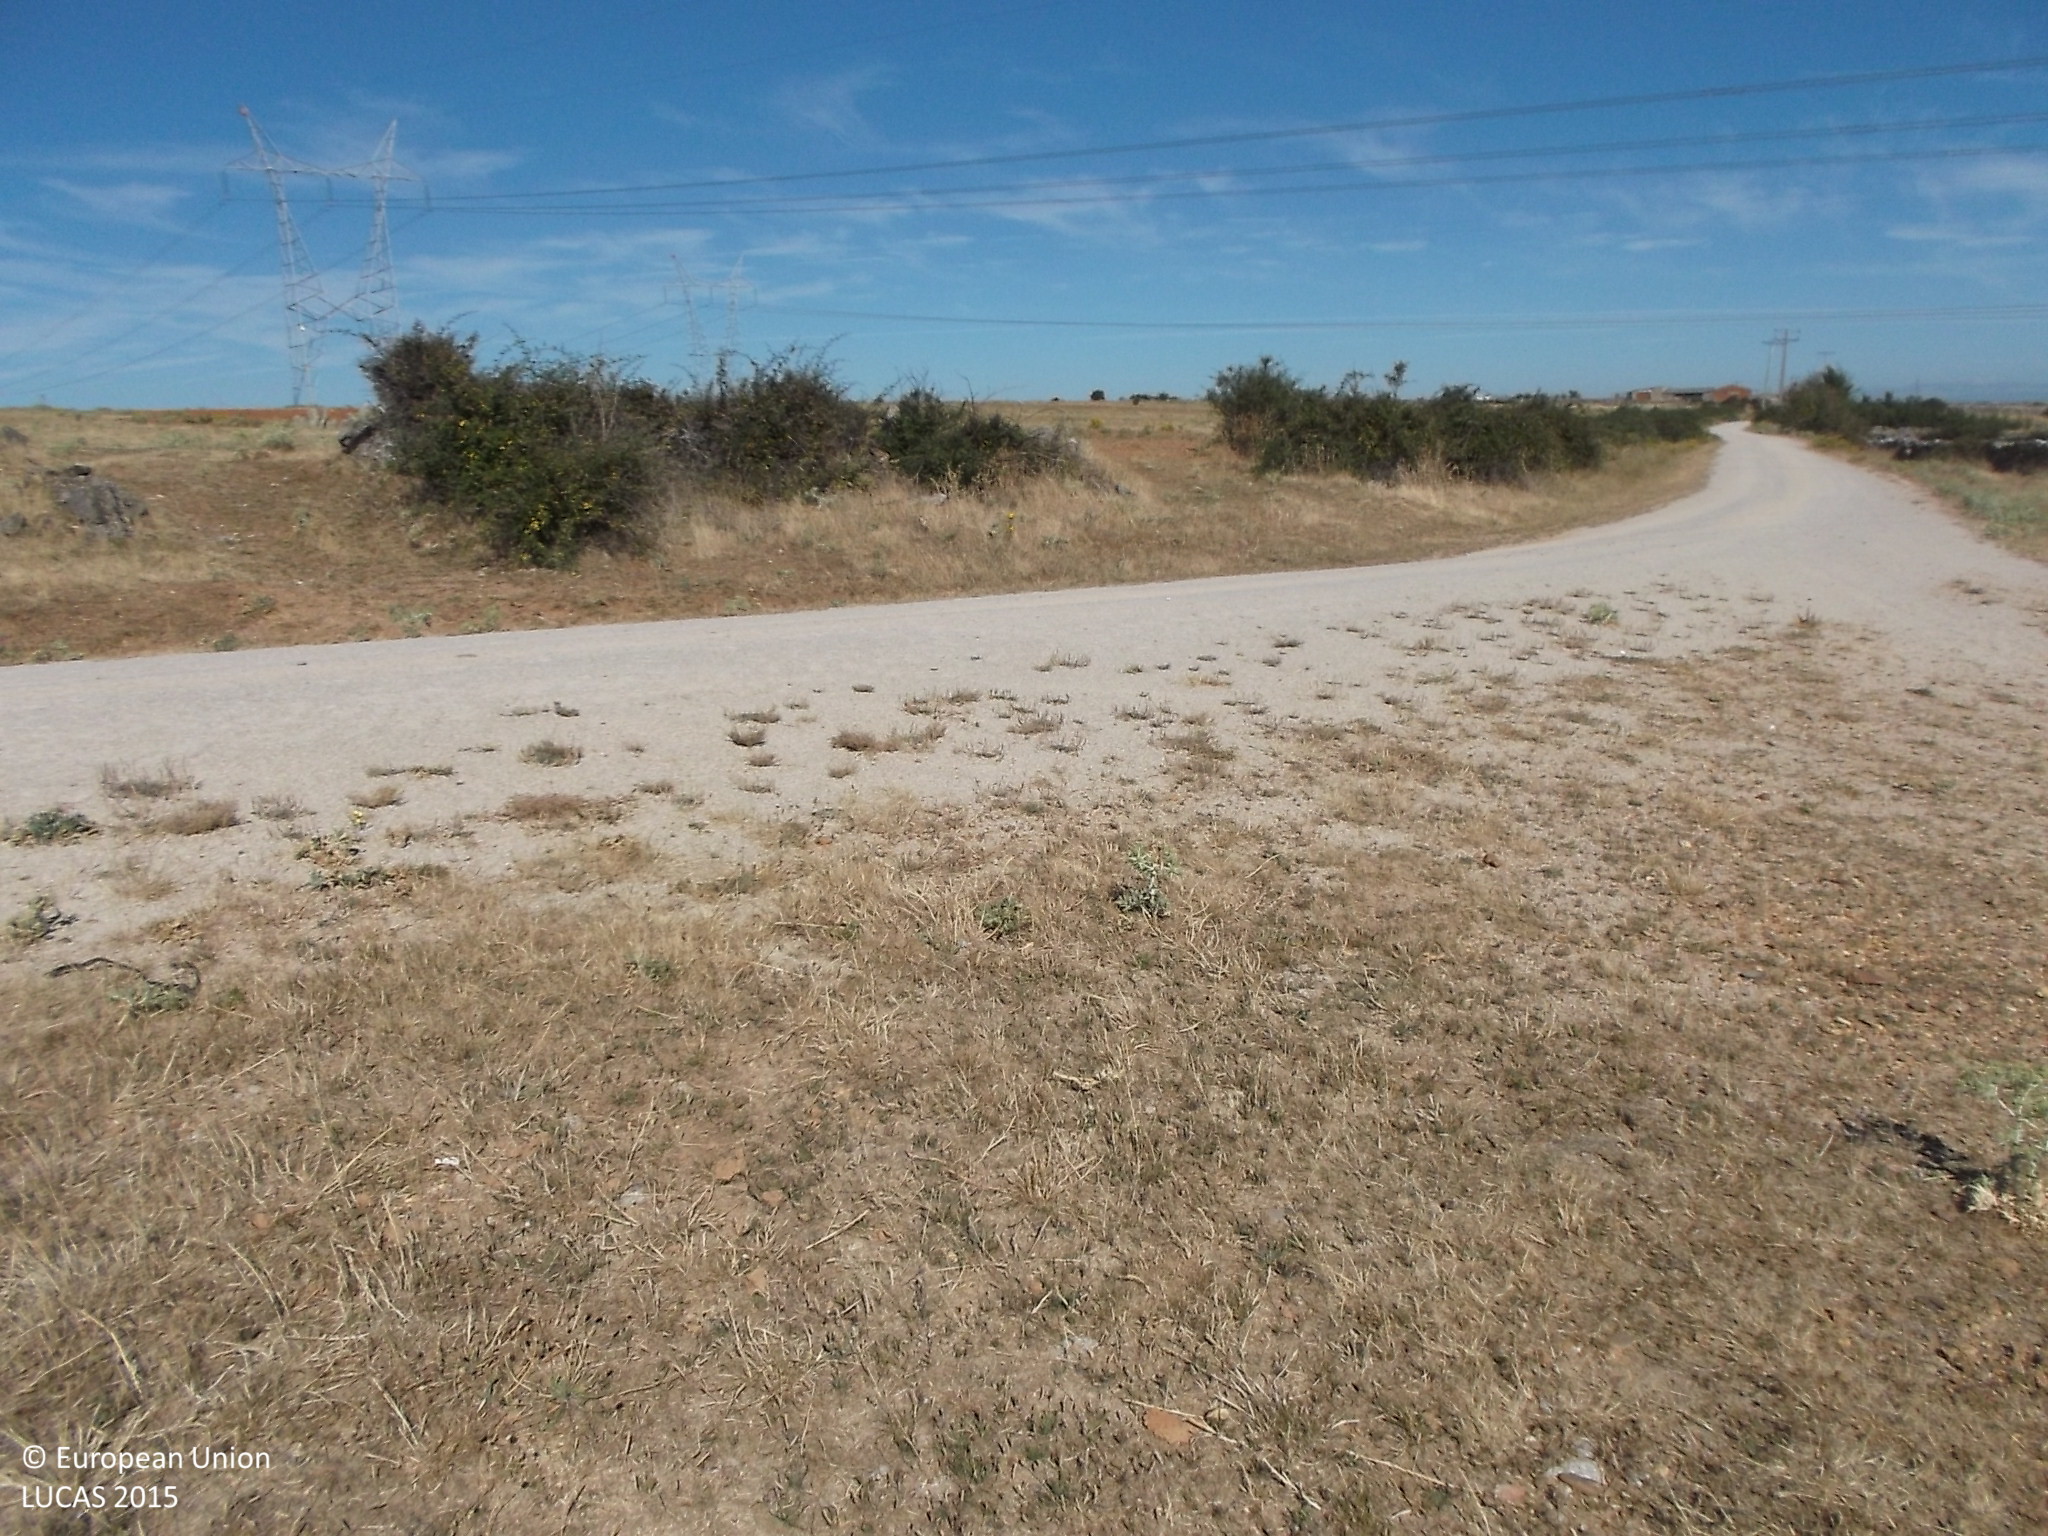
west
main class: Grassland
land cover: Grassland without tree/shrub cover
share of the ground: > 75 %
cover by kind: herbaceous plants 100 %
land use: Agriculture (excluding fallow land and kitchen gardens)
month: July
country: ES
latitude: 41.5129
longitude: -6.0406
